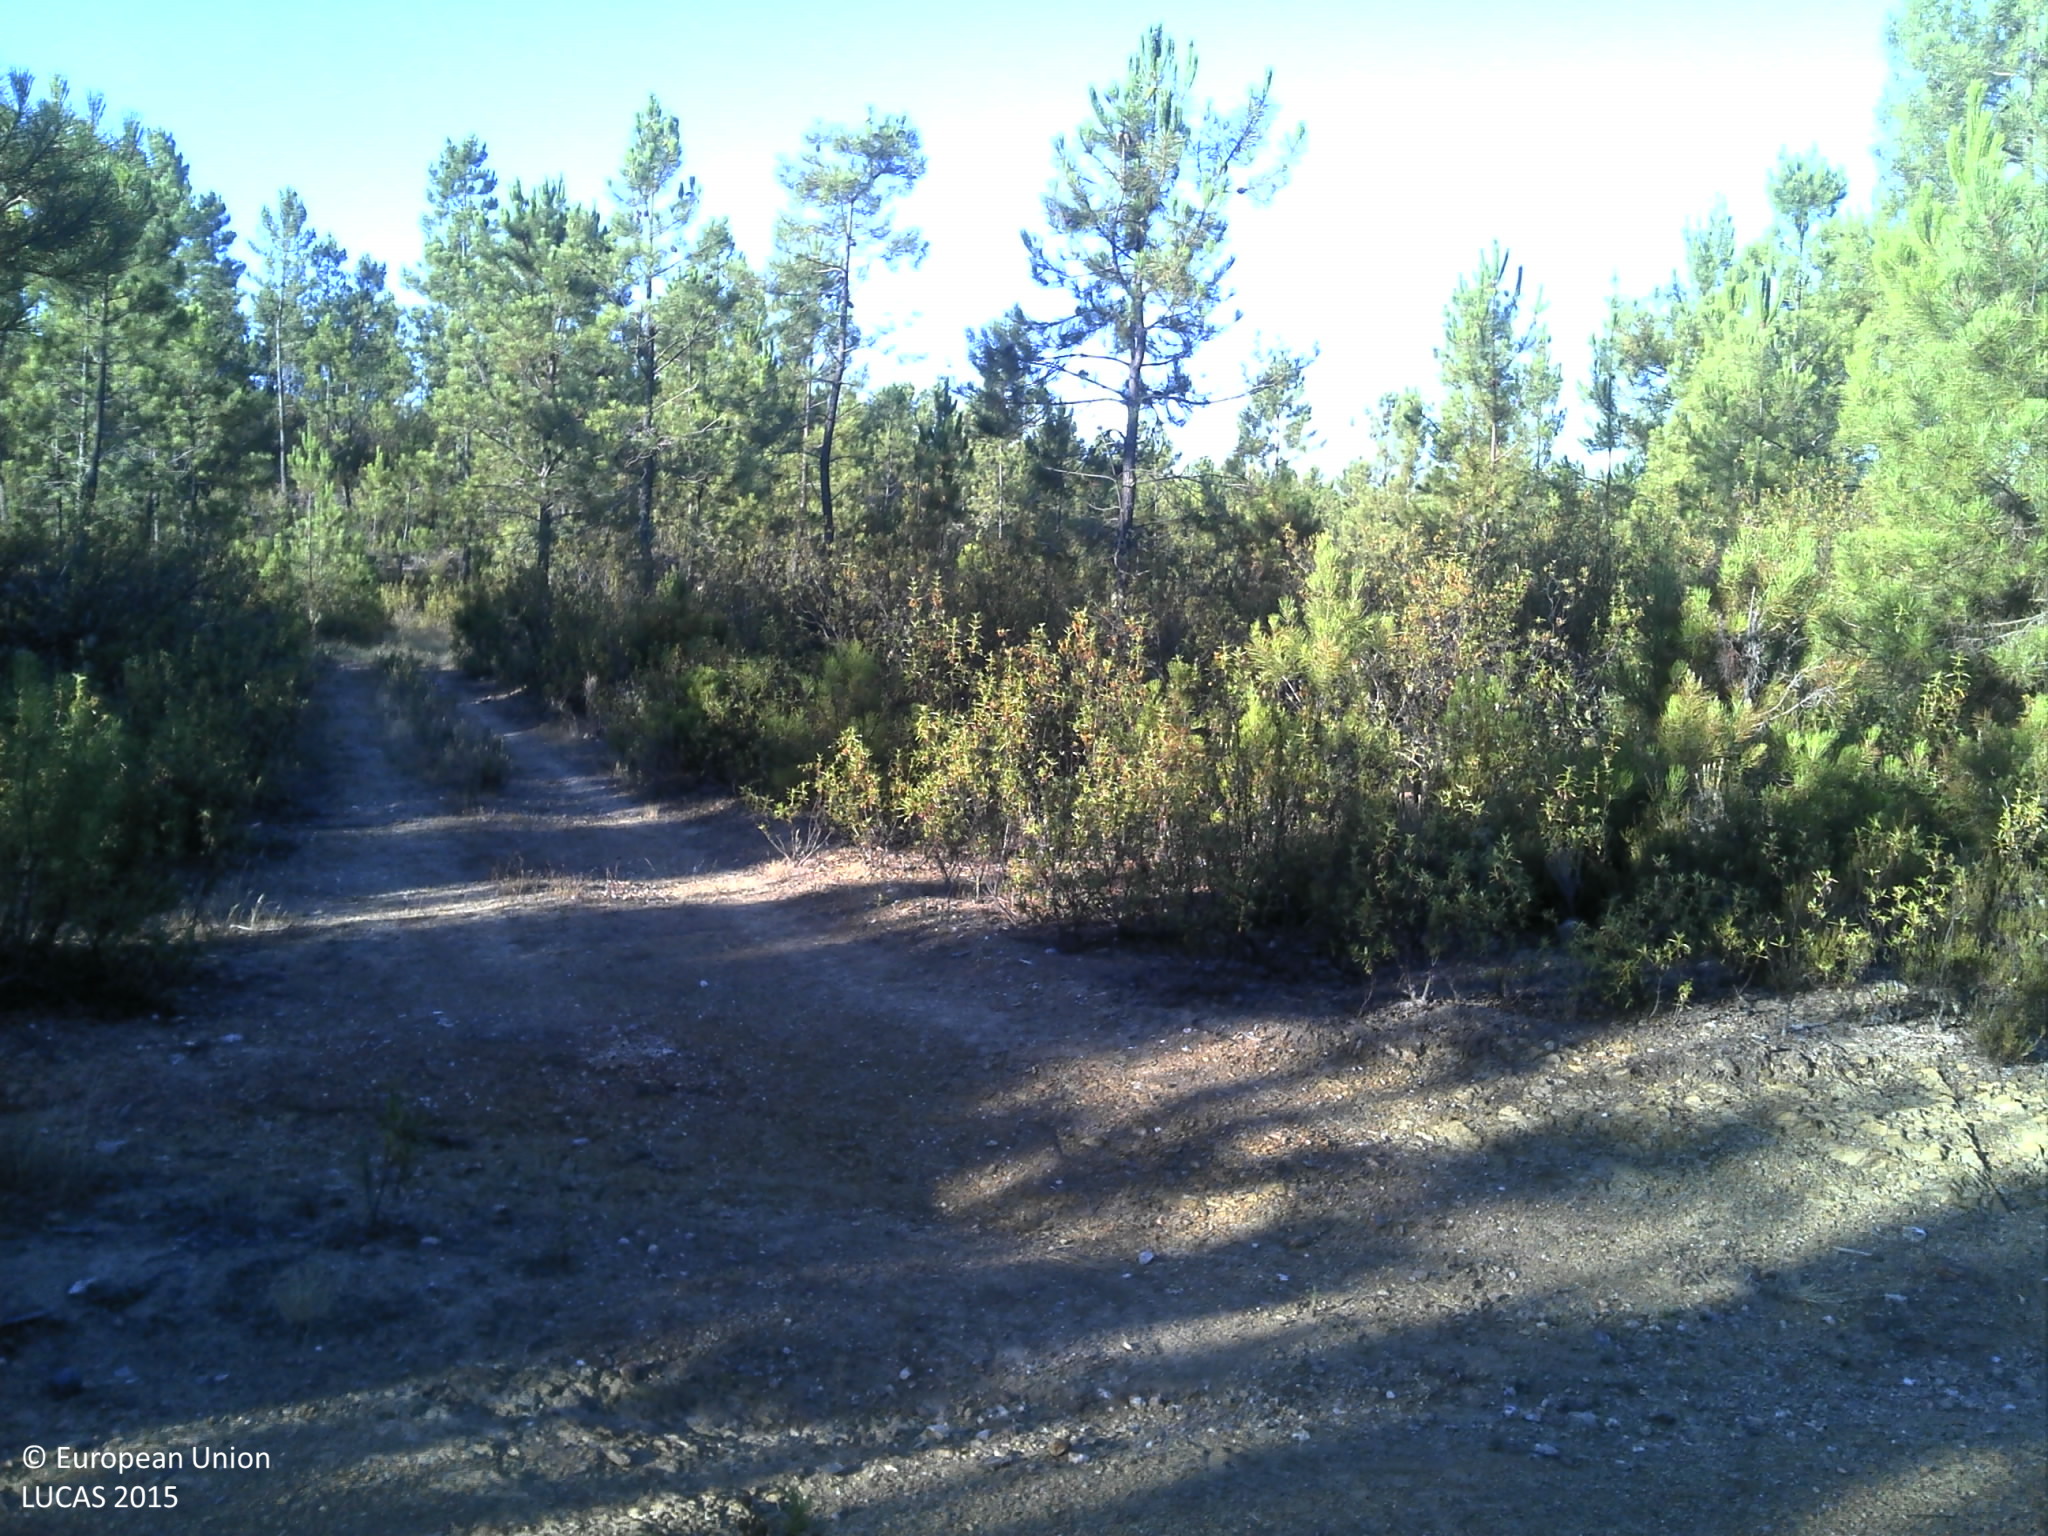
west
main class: Woodland
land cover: Pine dominated coniferous woodland
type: coniferous forest of the mediterranean region
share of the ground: 50 - 75 %
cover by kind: coniferous forest trees 70 %, shrubs 20 %, unconsolidated bare surface 5 %
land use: Forestry
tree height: > 5 m
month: July
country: PT
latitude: 39.9890
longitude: -7.6135
